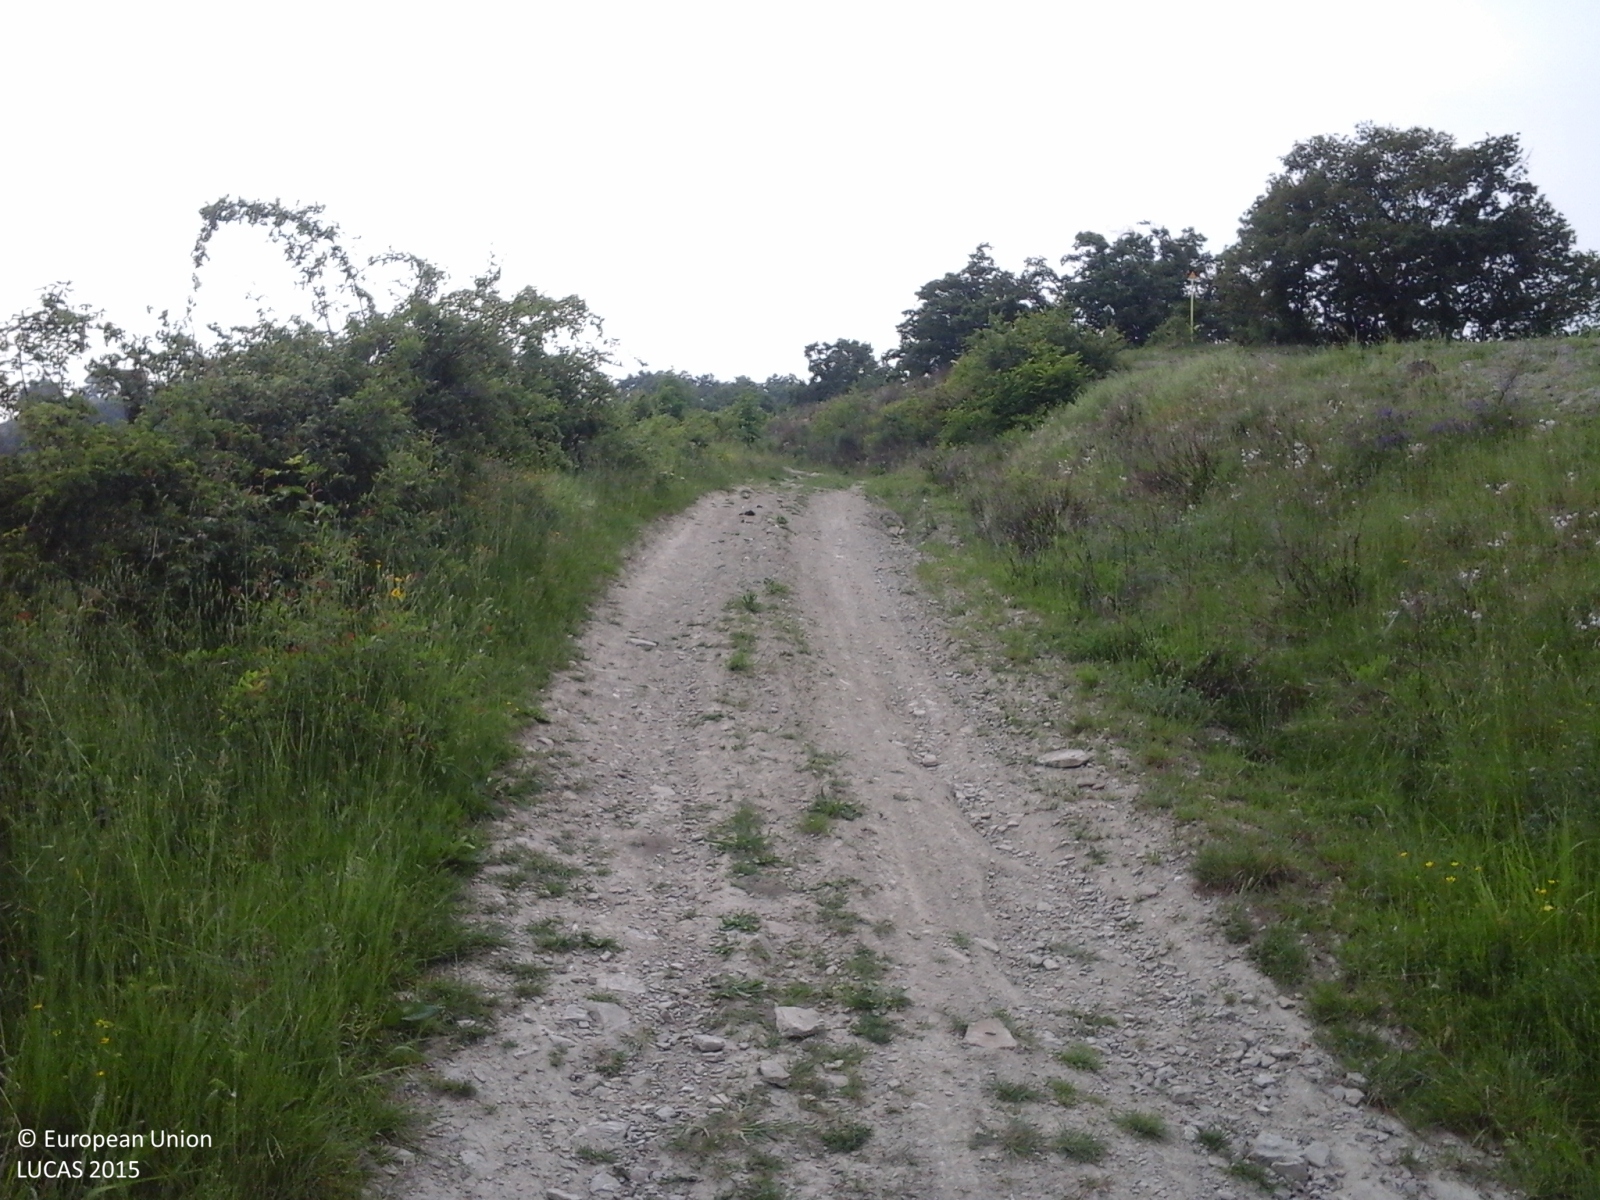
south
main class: Woodland
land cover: Broadleaved woodland
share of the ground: 50 - 75 %
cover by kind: broadleaved forest trees 60 %, herbaceous plants 30 %, shrubs 10 %
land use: Amenities, museums, leisure
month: May
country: IT
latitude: 44.4549
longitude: 10.8903
